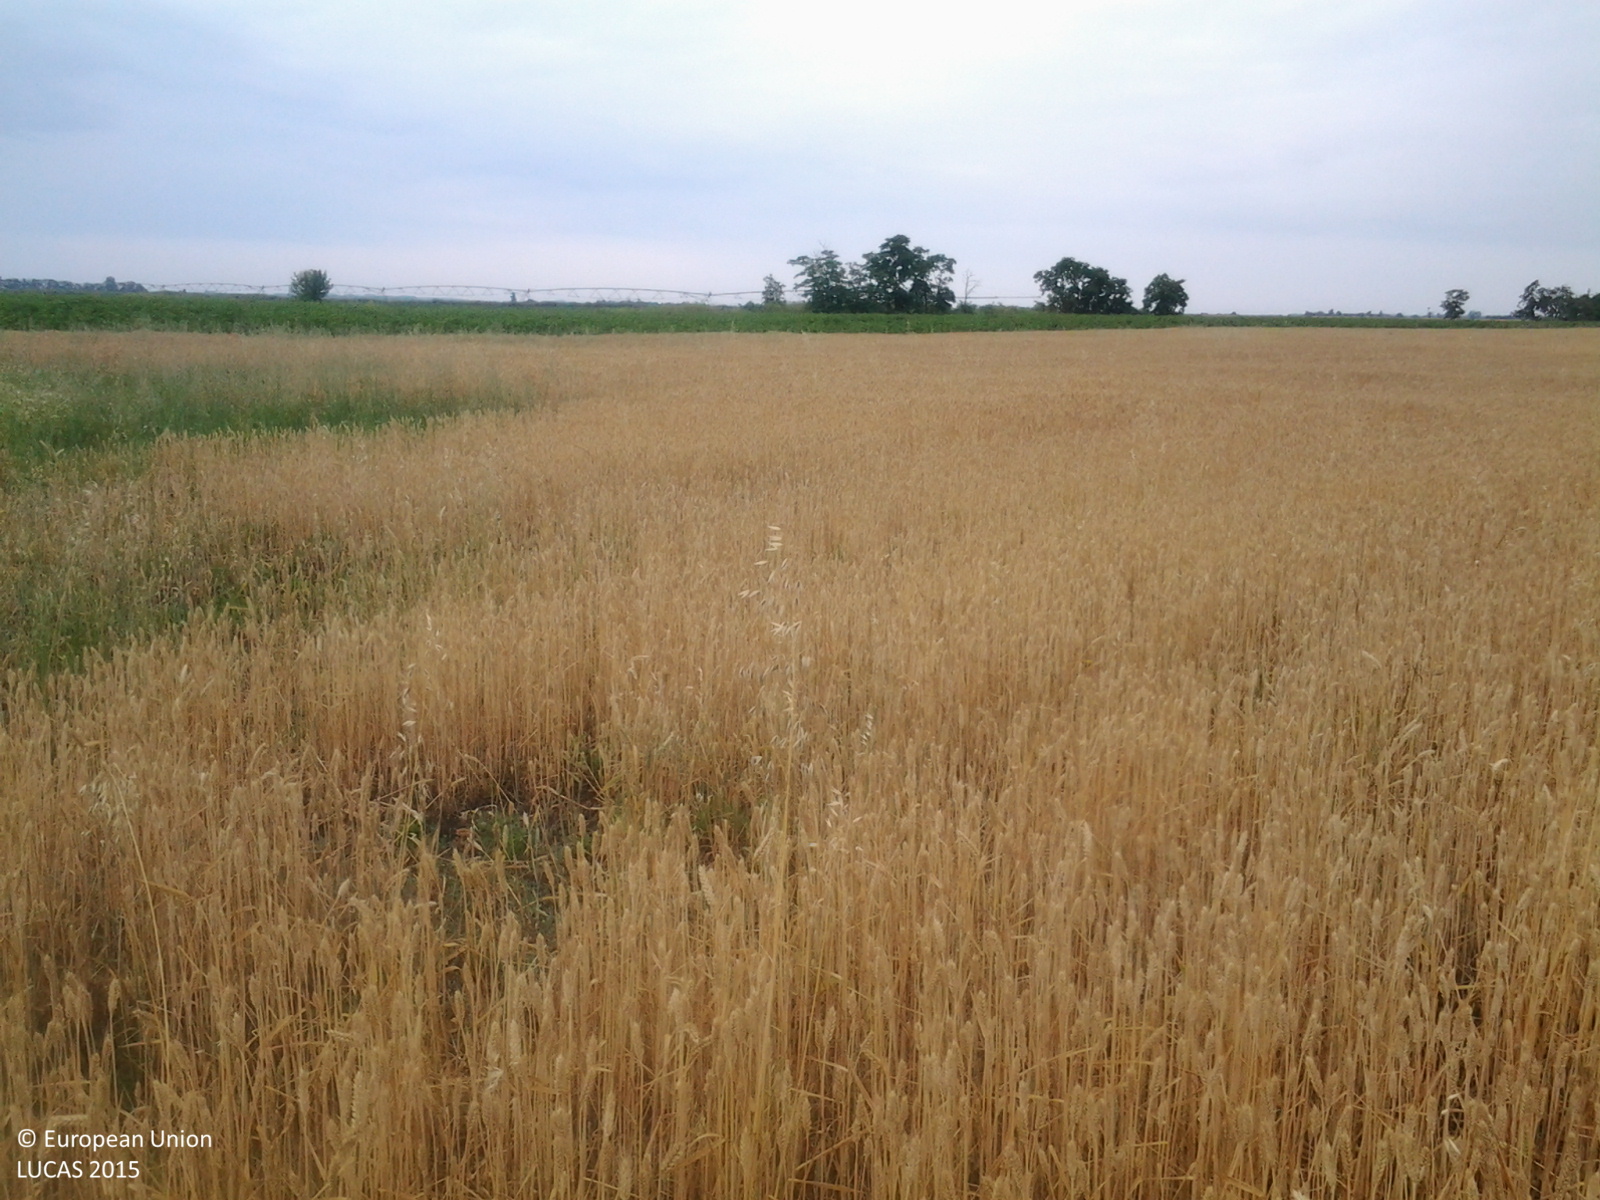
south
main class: Cropland
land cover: Common wheat
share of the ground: > 75 %
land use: Agriculture (excluding fallow land and kitchen gardens)
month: June
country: HU
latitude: 46.8566
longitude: 20.4286
